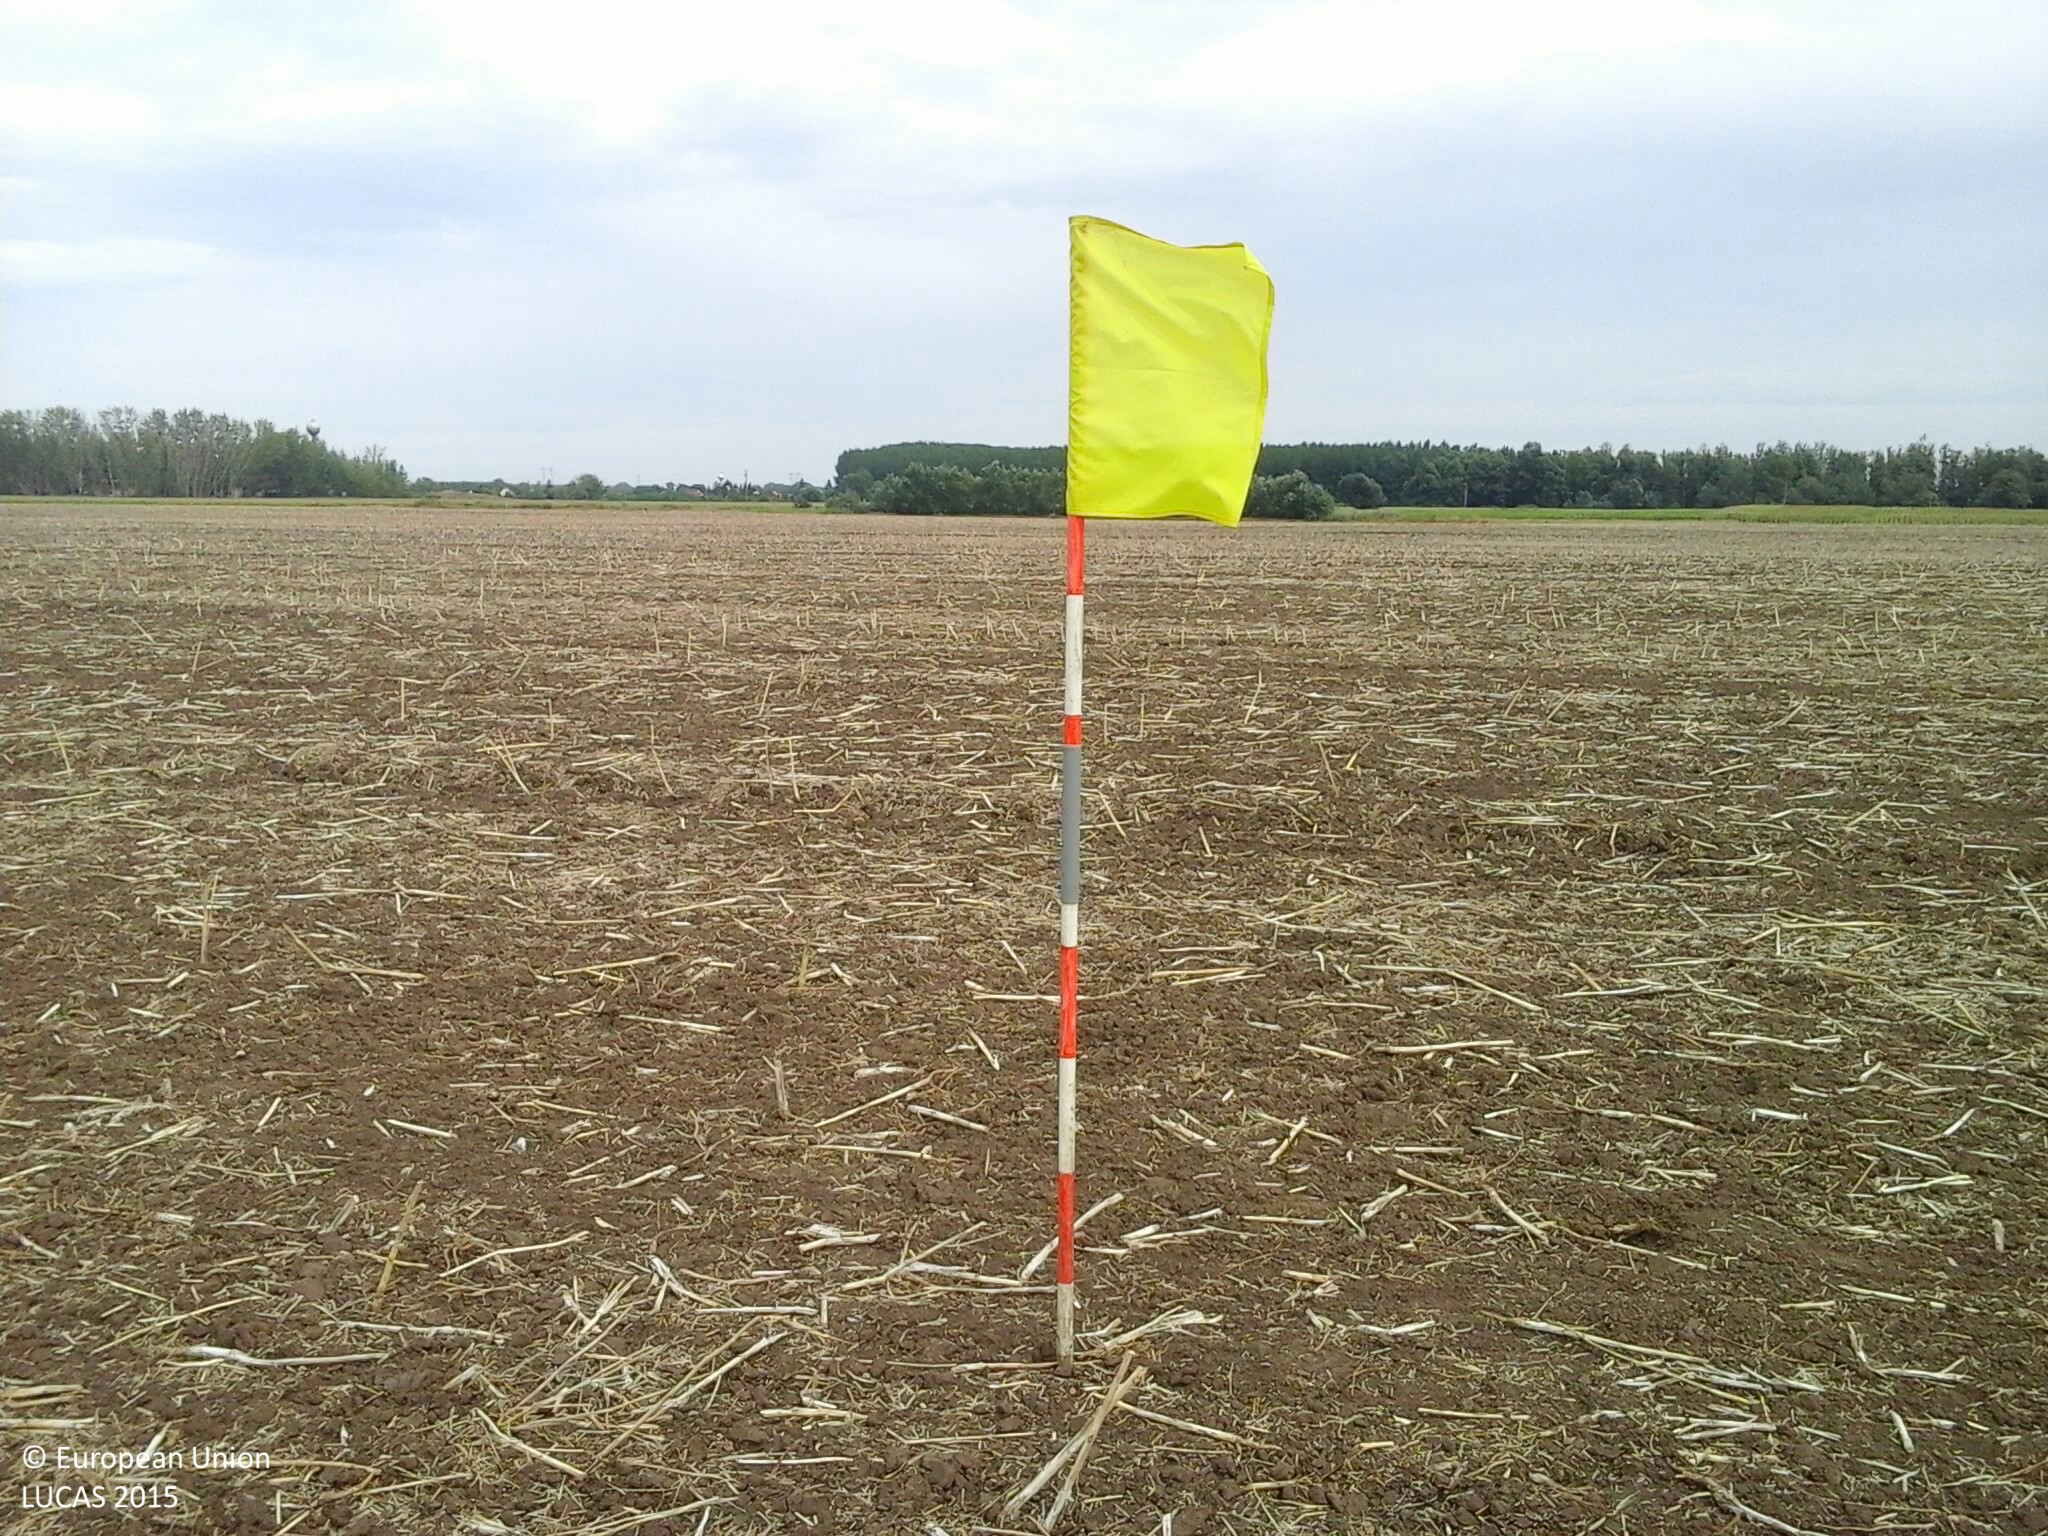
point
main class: Cropland
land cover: Rape and turnip rape
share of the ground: 25 - 50 %
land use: Agriculture (excluding fallow land and kitchen gardens)
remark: Harvested field
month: July
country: HU
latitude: 47.8696
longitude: 21.0144
